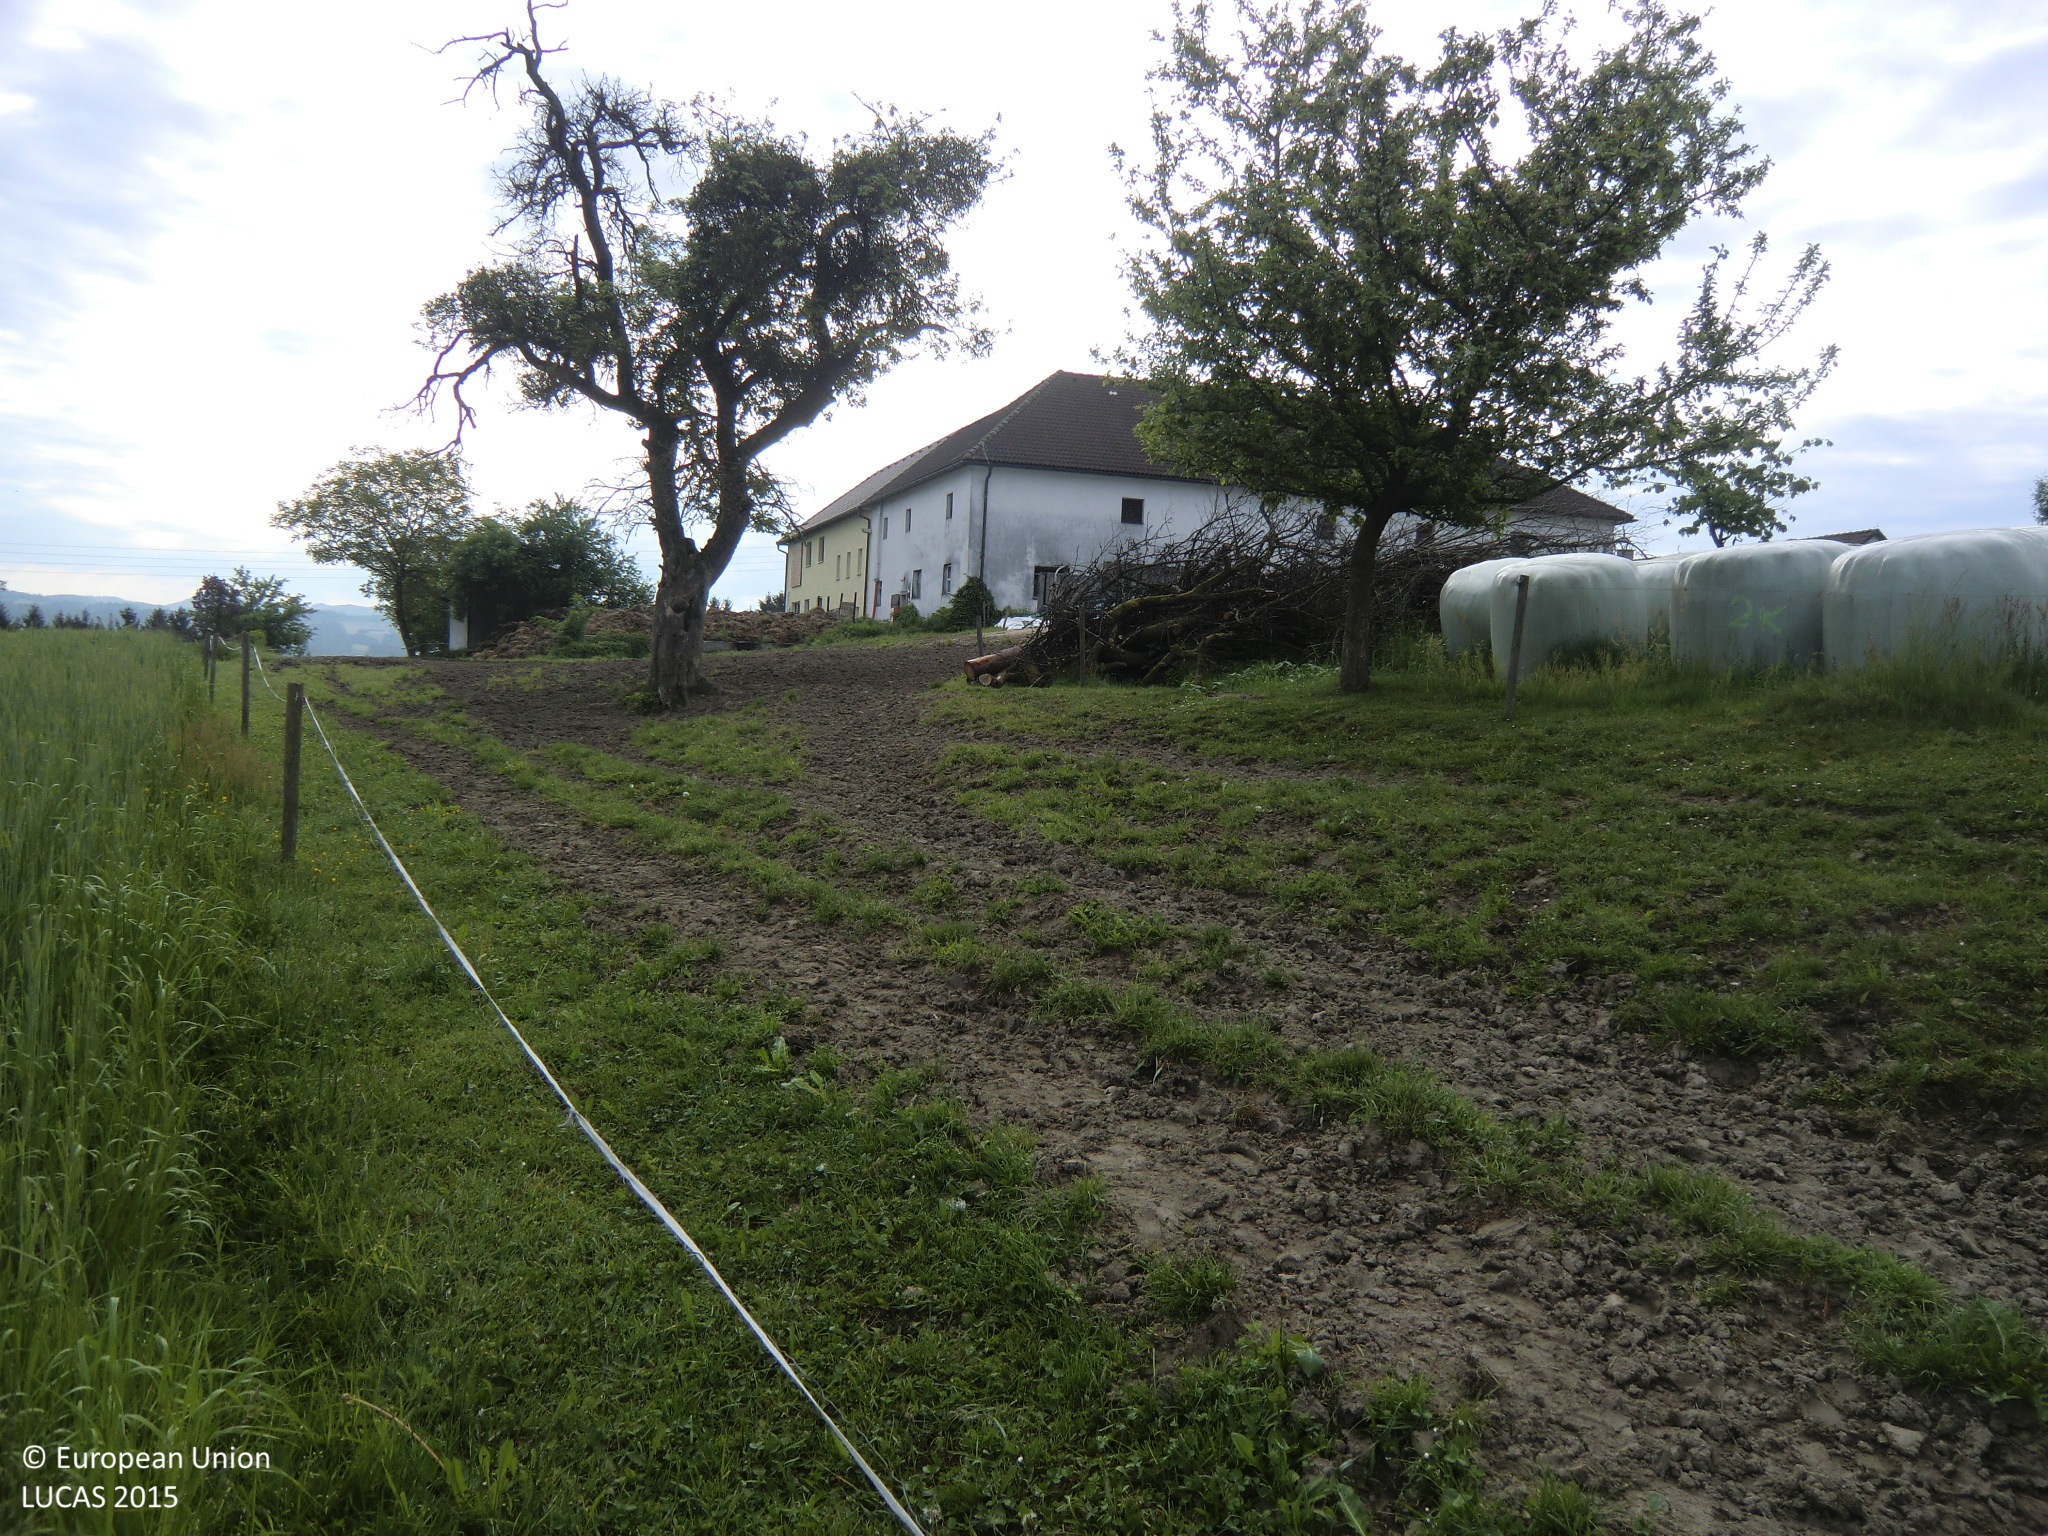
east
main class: Grassland
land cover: Grassland without tree/shrub cover
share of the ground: > 75 %
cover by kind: herbaceous plants 80 %, unconsolidated bare surface 20 %
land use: Agriculture (excluding fallow land and kitchen gardens)
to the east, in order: Grassland without tree/shrub cover; Fences; Pear fruit; Grassland without tree/shrub cover; Fences; Grassland with sparse tree/shrub cover; Artificial constructions in urban areas; Grass margins; Potatoes; Paved roads, cycling and walking lanes; Grassland without tree/shrub cover; Spruce dominated mixed woodland; Fences; Tracks; Spruce dominated coniferous woodland
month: May
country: AT
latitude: 48.3079
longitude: 14.5983
